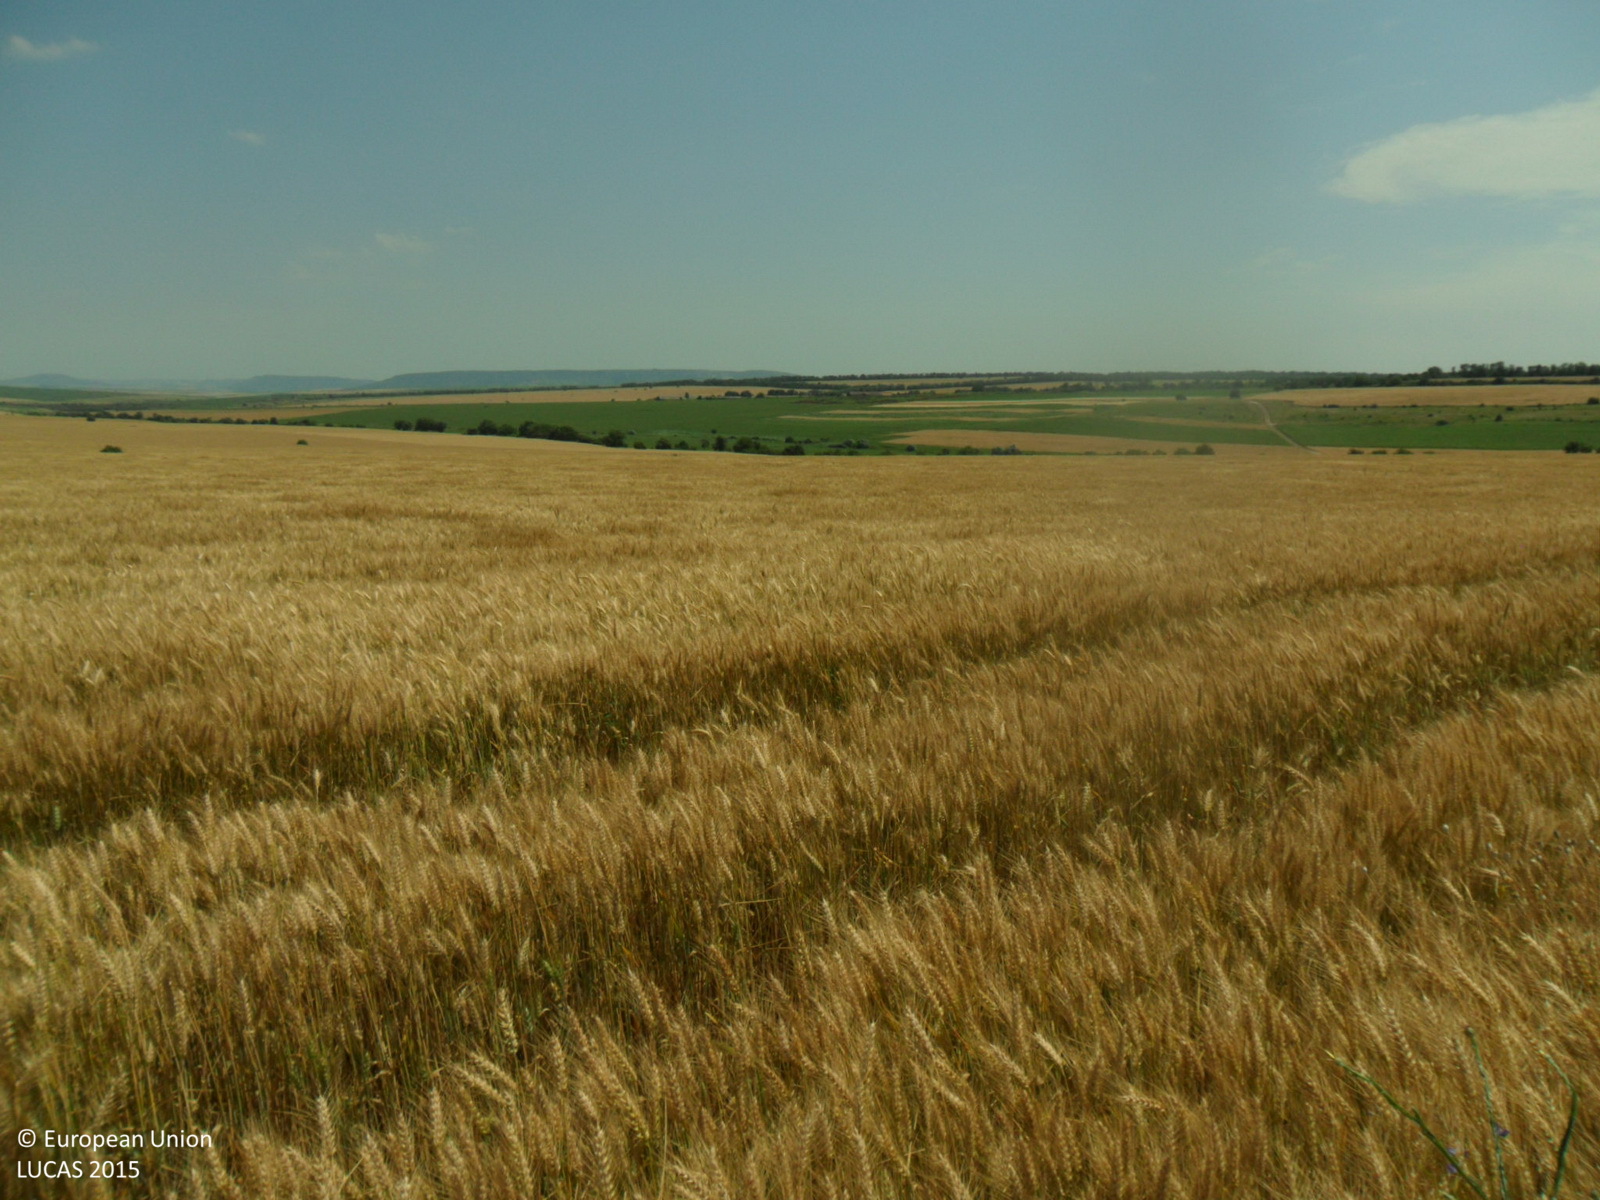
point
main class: Cropland
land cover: Common wheat
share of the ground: > 75 %
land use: Agriculture (excluding fallow land and kitchen gardens)
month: June
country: BG
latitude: 43.3789
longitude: 26.9883
